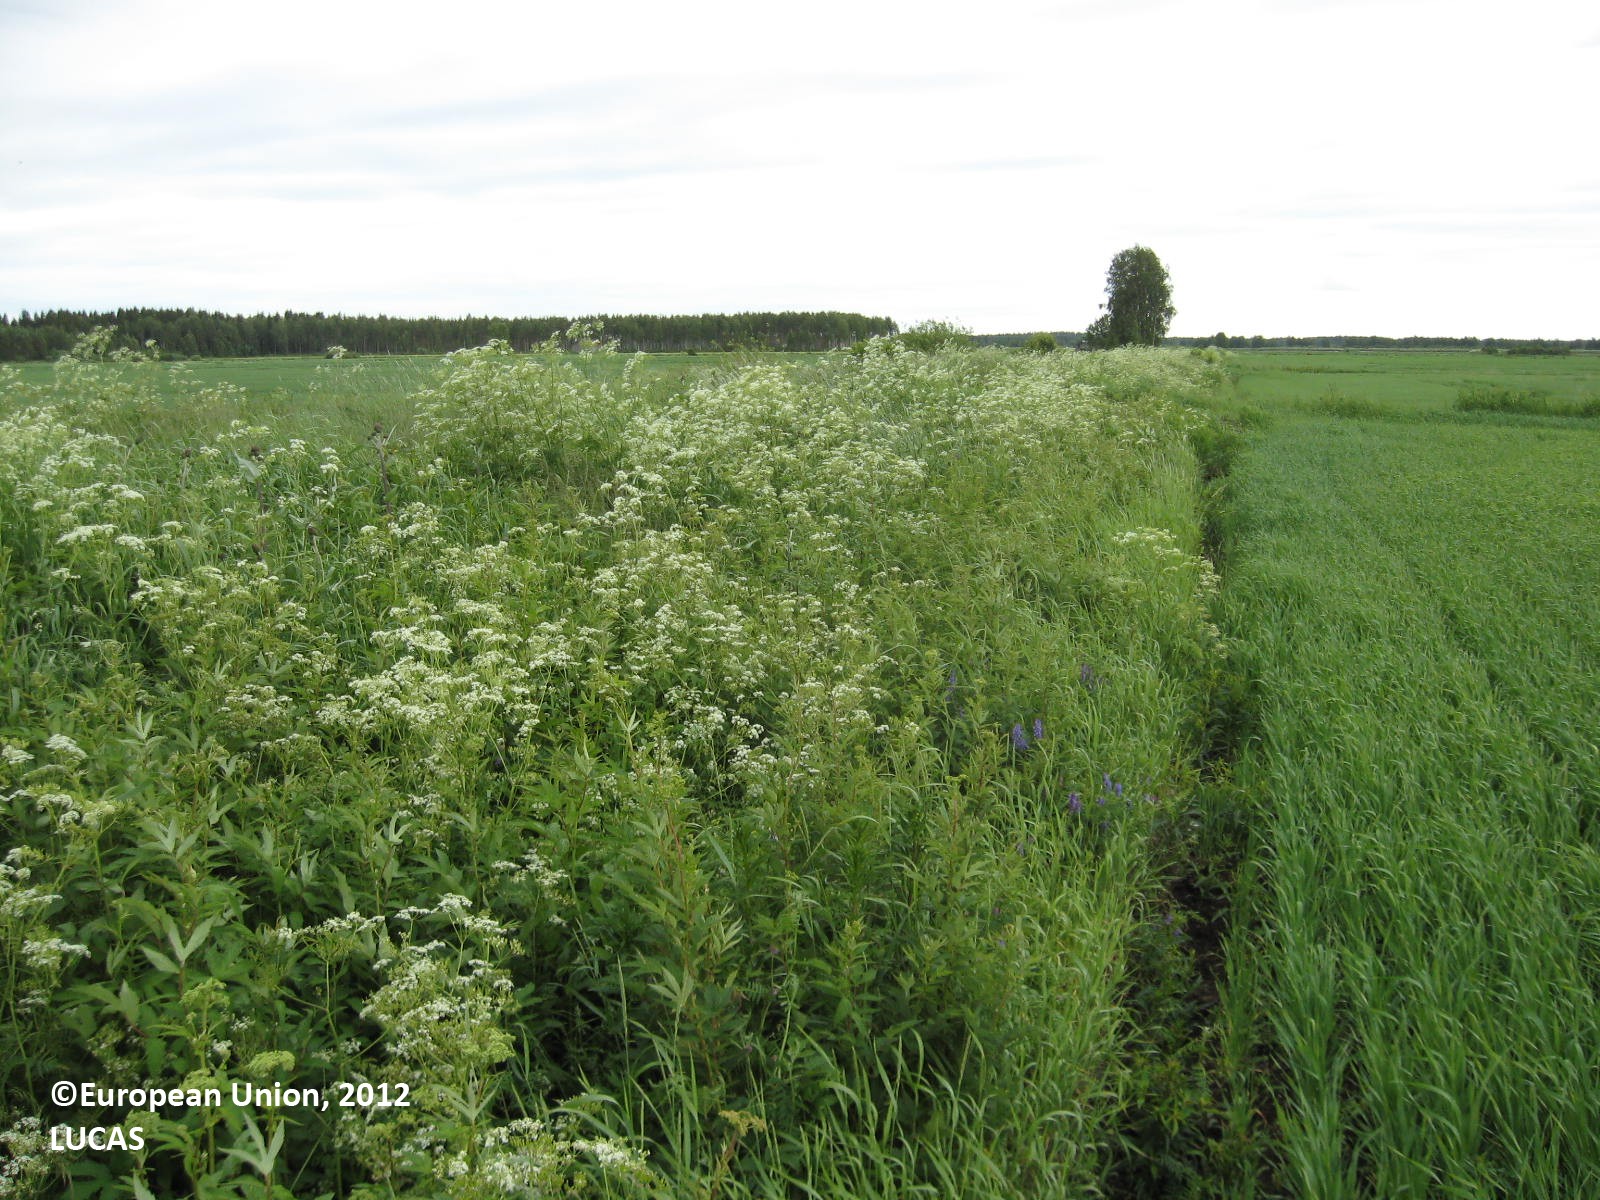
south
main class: Cropland
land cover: Barley
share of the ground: > 75 %
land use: Agriculture (excluding fallow land and kitchen gardens)
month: June
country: FI
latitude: 62.8681
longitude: 22.8132
